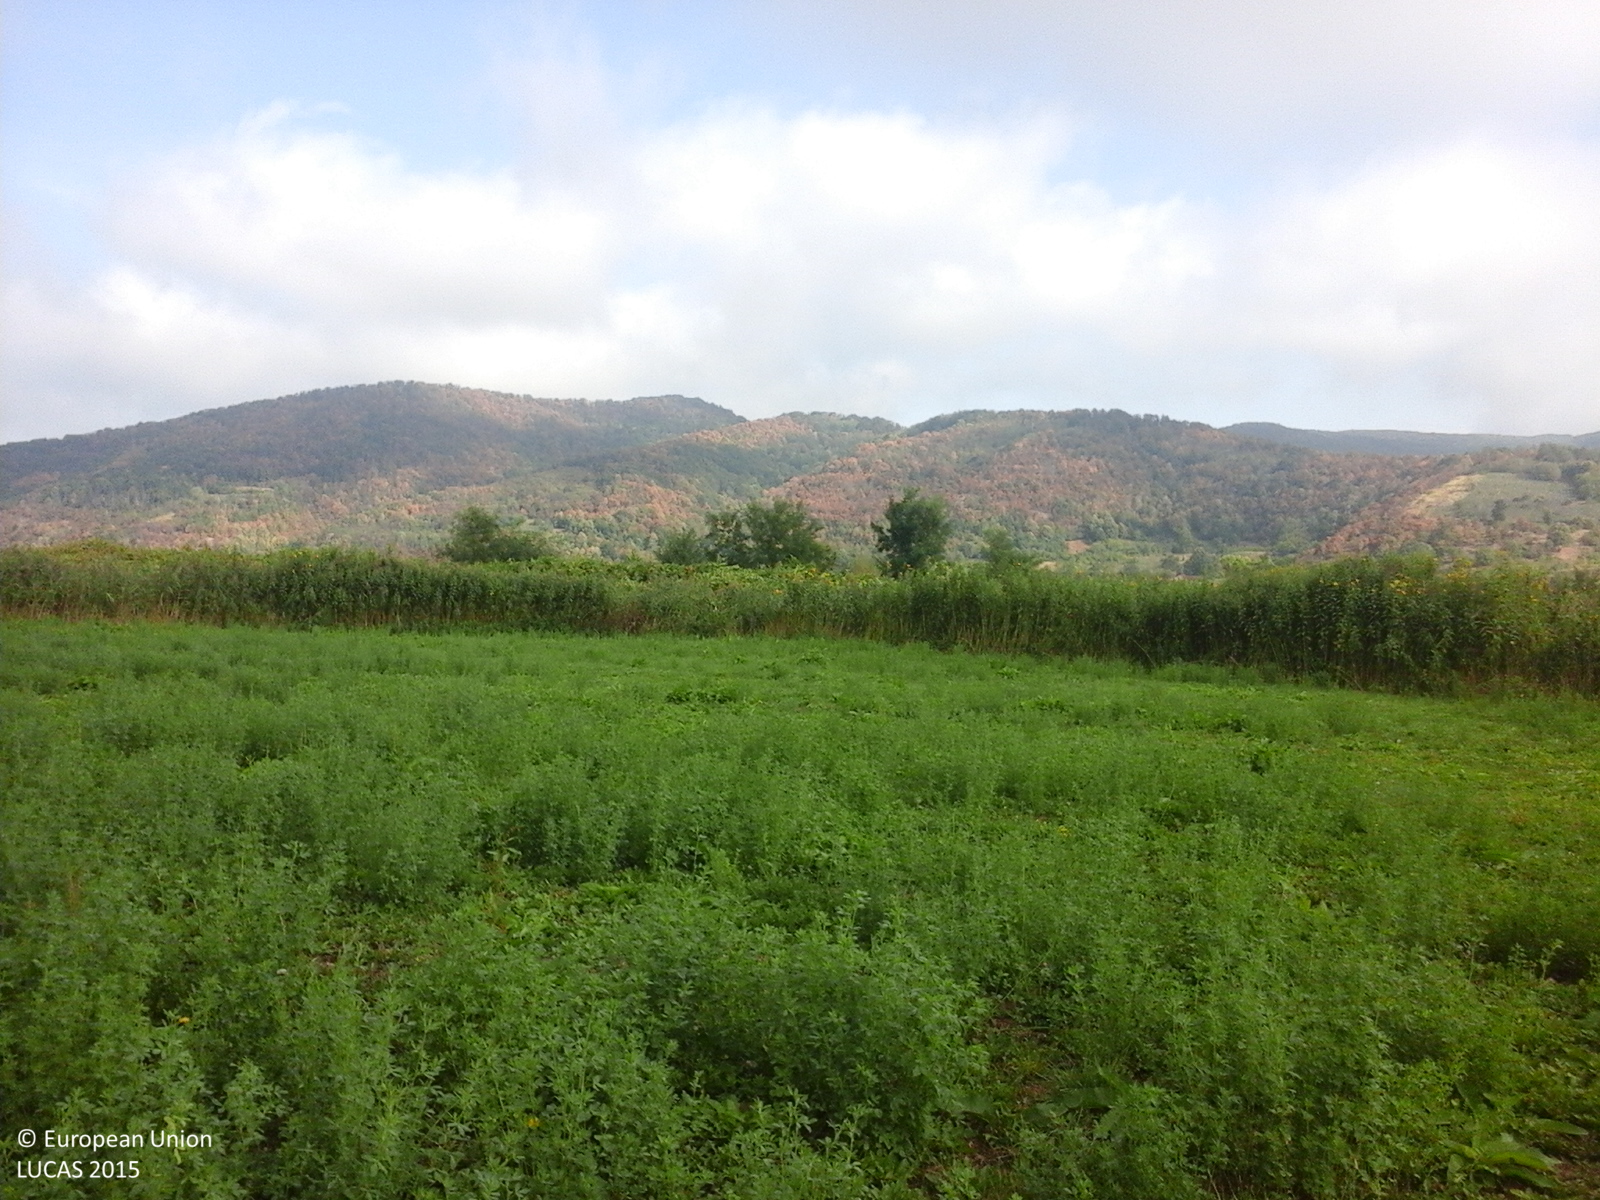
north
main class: Cropland
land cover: Lucerne
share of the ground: > 75 %
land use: Agriculture (excluding fallow land and kitchen gardens)
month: September
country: RO
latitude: 47.6947
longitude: 23.3839
